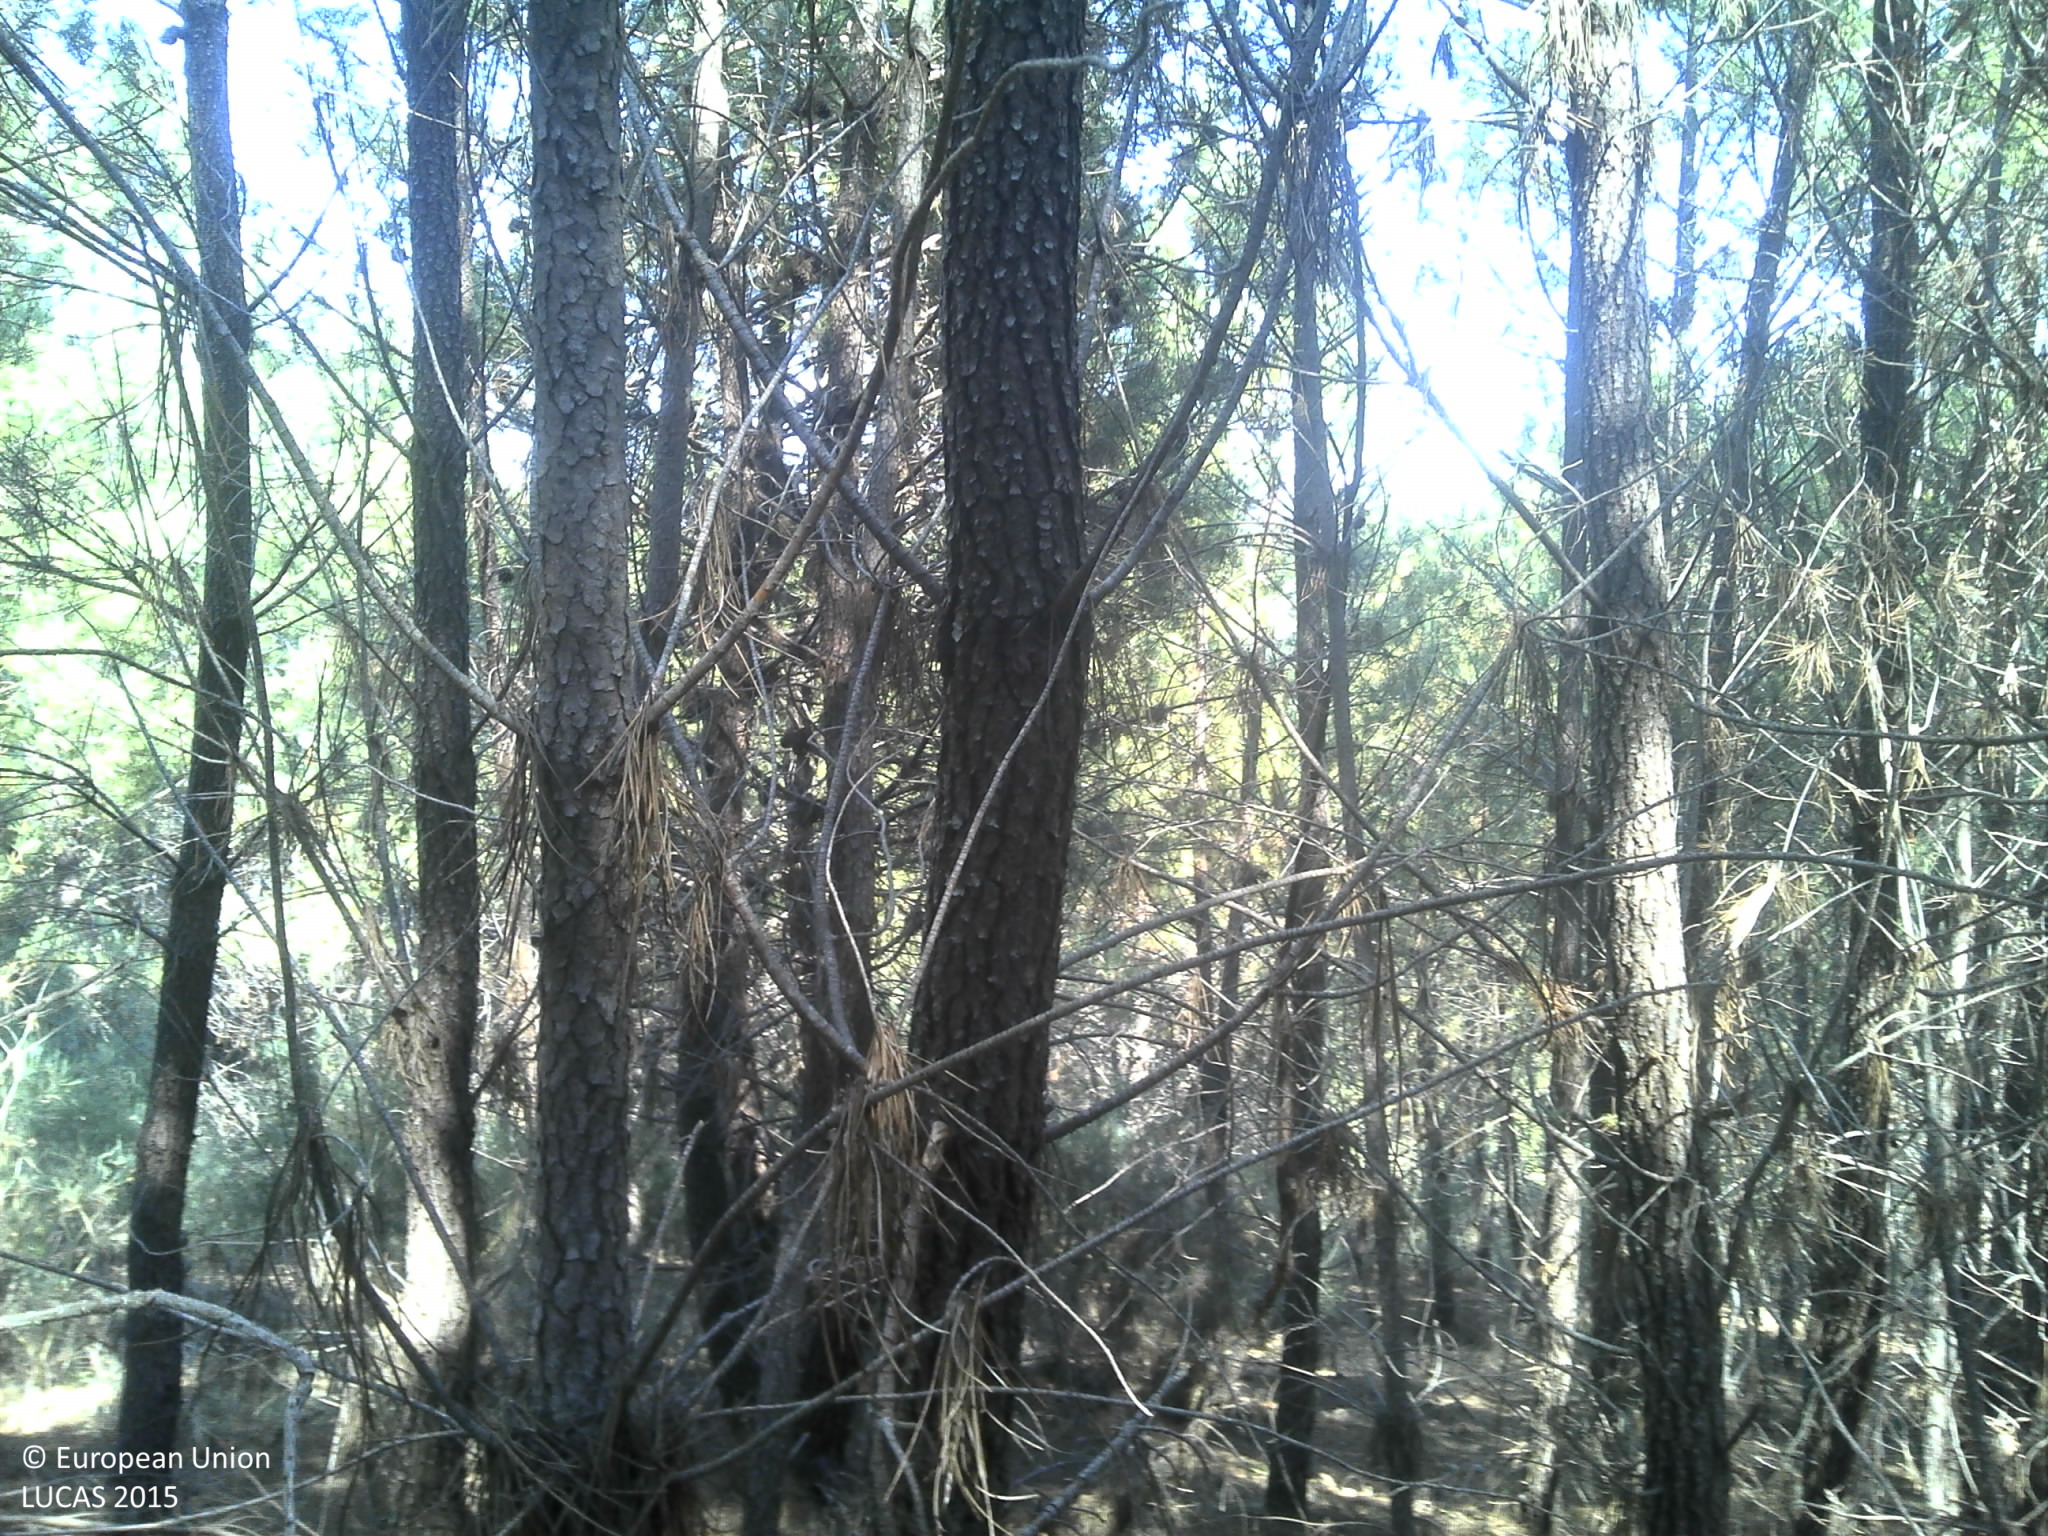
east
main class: Woodland
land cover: Pine dominated coniferous woodland
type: coniferous forest of the mediterranean region
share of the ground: > 75 %
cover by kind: coniferous forest trees 75 %, shrubs 15 %, unconsolidated bare surface 5 %
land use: Forestry
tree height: > 5 m
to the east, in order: Pine dominated coniferous woodland; Tracks; Pine dominated coniferous woodland; Shrubland with sparse tree cover; Grassland with sparse tree/shrub cover
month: June
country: PT
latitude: 40.2987
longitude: -7.1218
